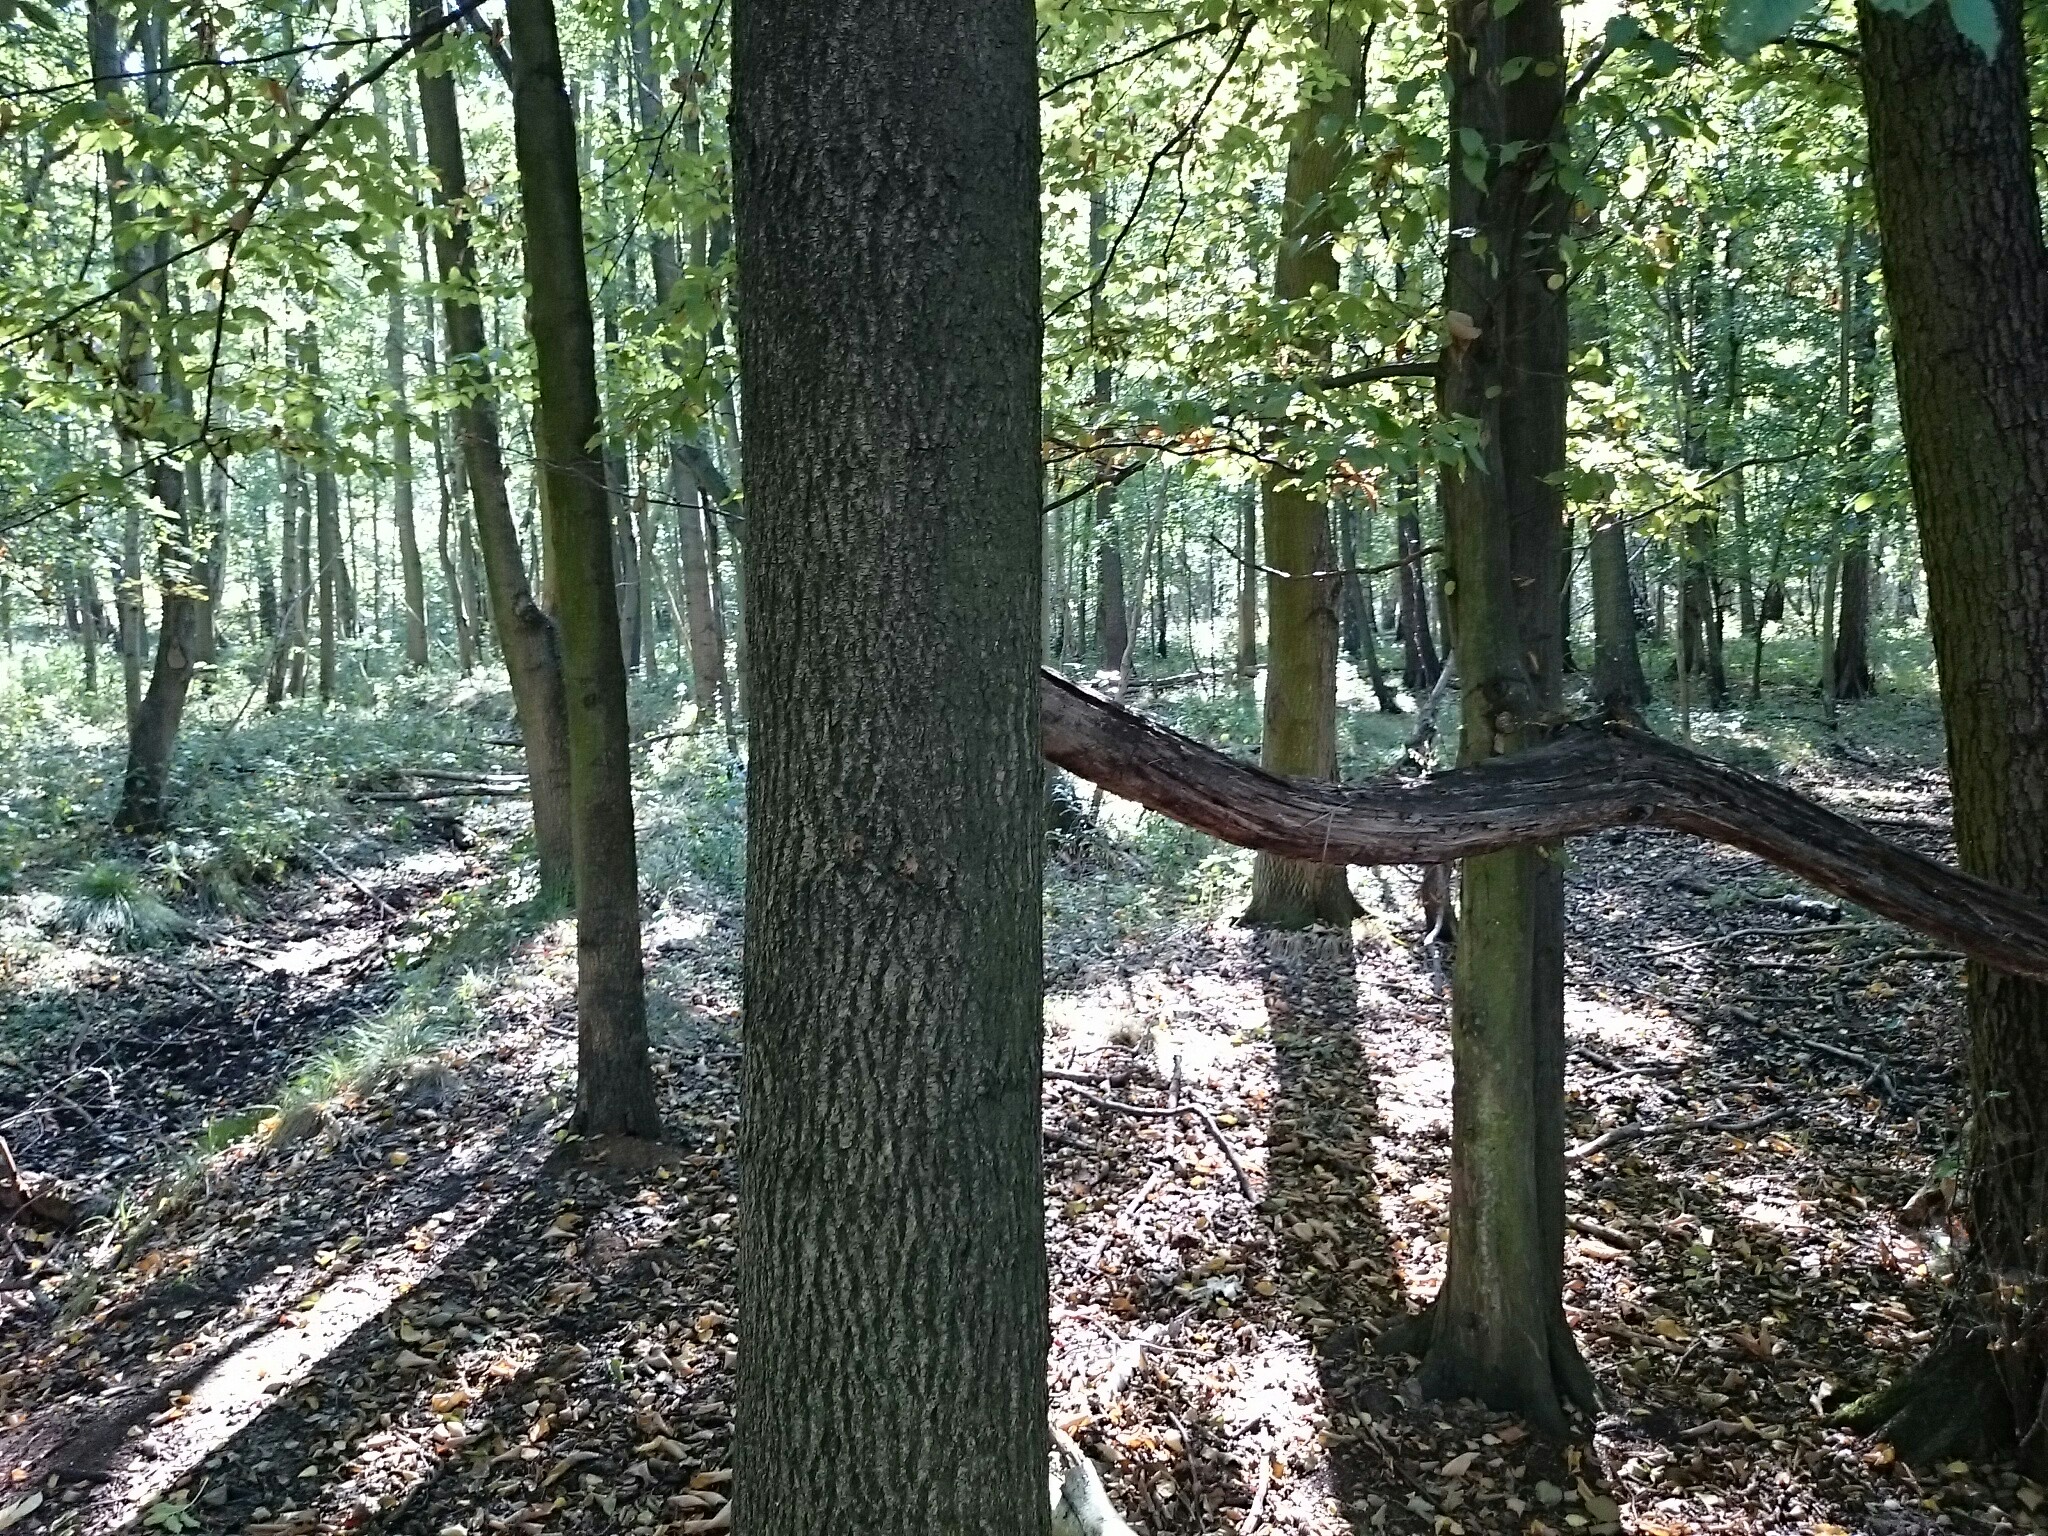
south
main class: Woodland
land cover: Broadleaved woodland
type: mesophytic deciduous forest
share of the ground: > 75 %
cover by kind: broadleaved forest trees 80 %, unconsolidated bare surface 15 %, herbaceous plants 5 %
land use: Forestry
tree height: > 5 m
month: September
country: PL
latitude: 51.5357
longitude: 17.3501
